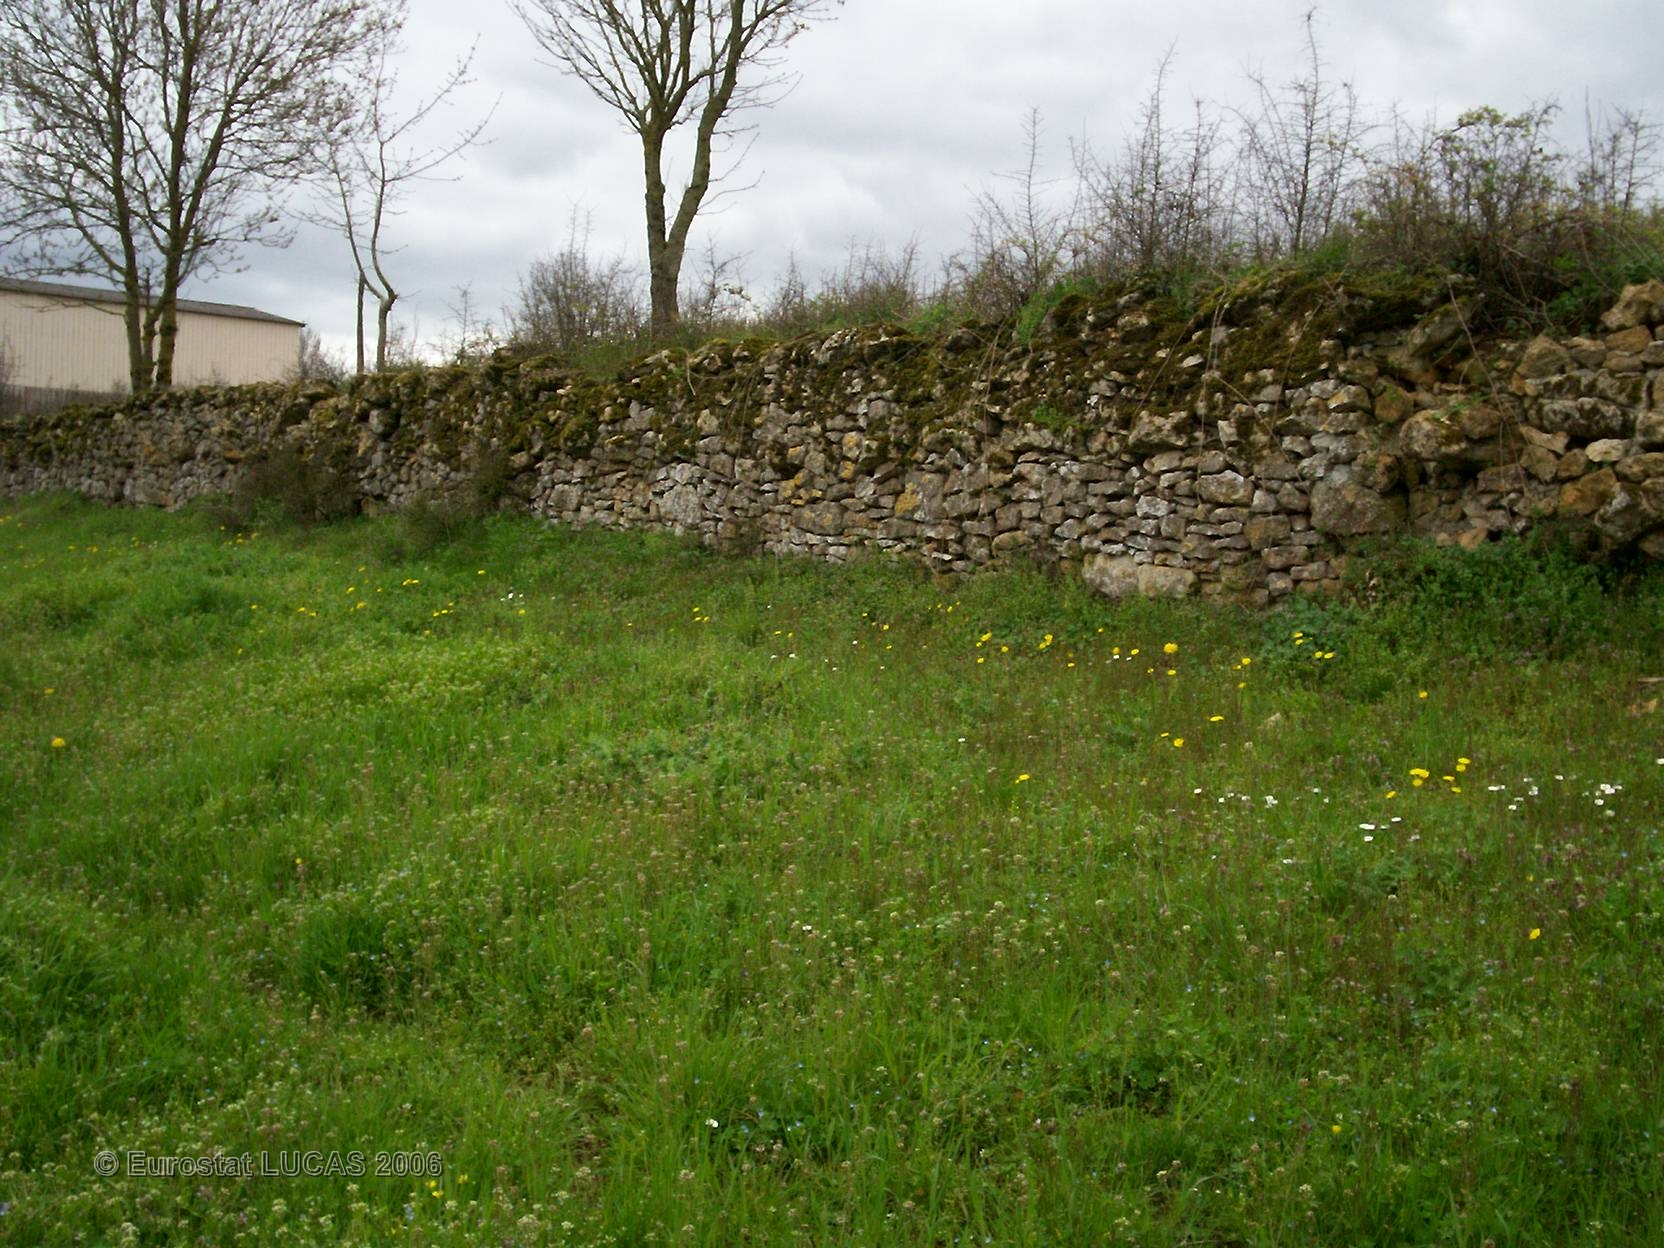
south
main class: Grassland
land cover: Grassland without tree/shrub cover
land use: Agriculture (excluding fallow land and kitchen gardens)
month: April
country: FR
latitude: 46.3095
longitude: -0.2685
